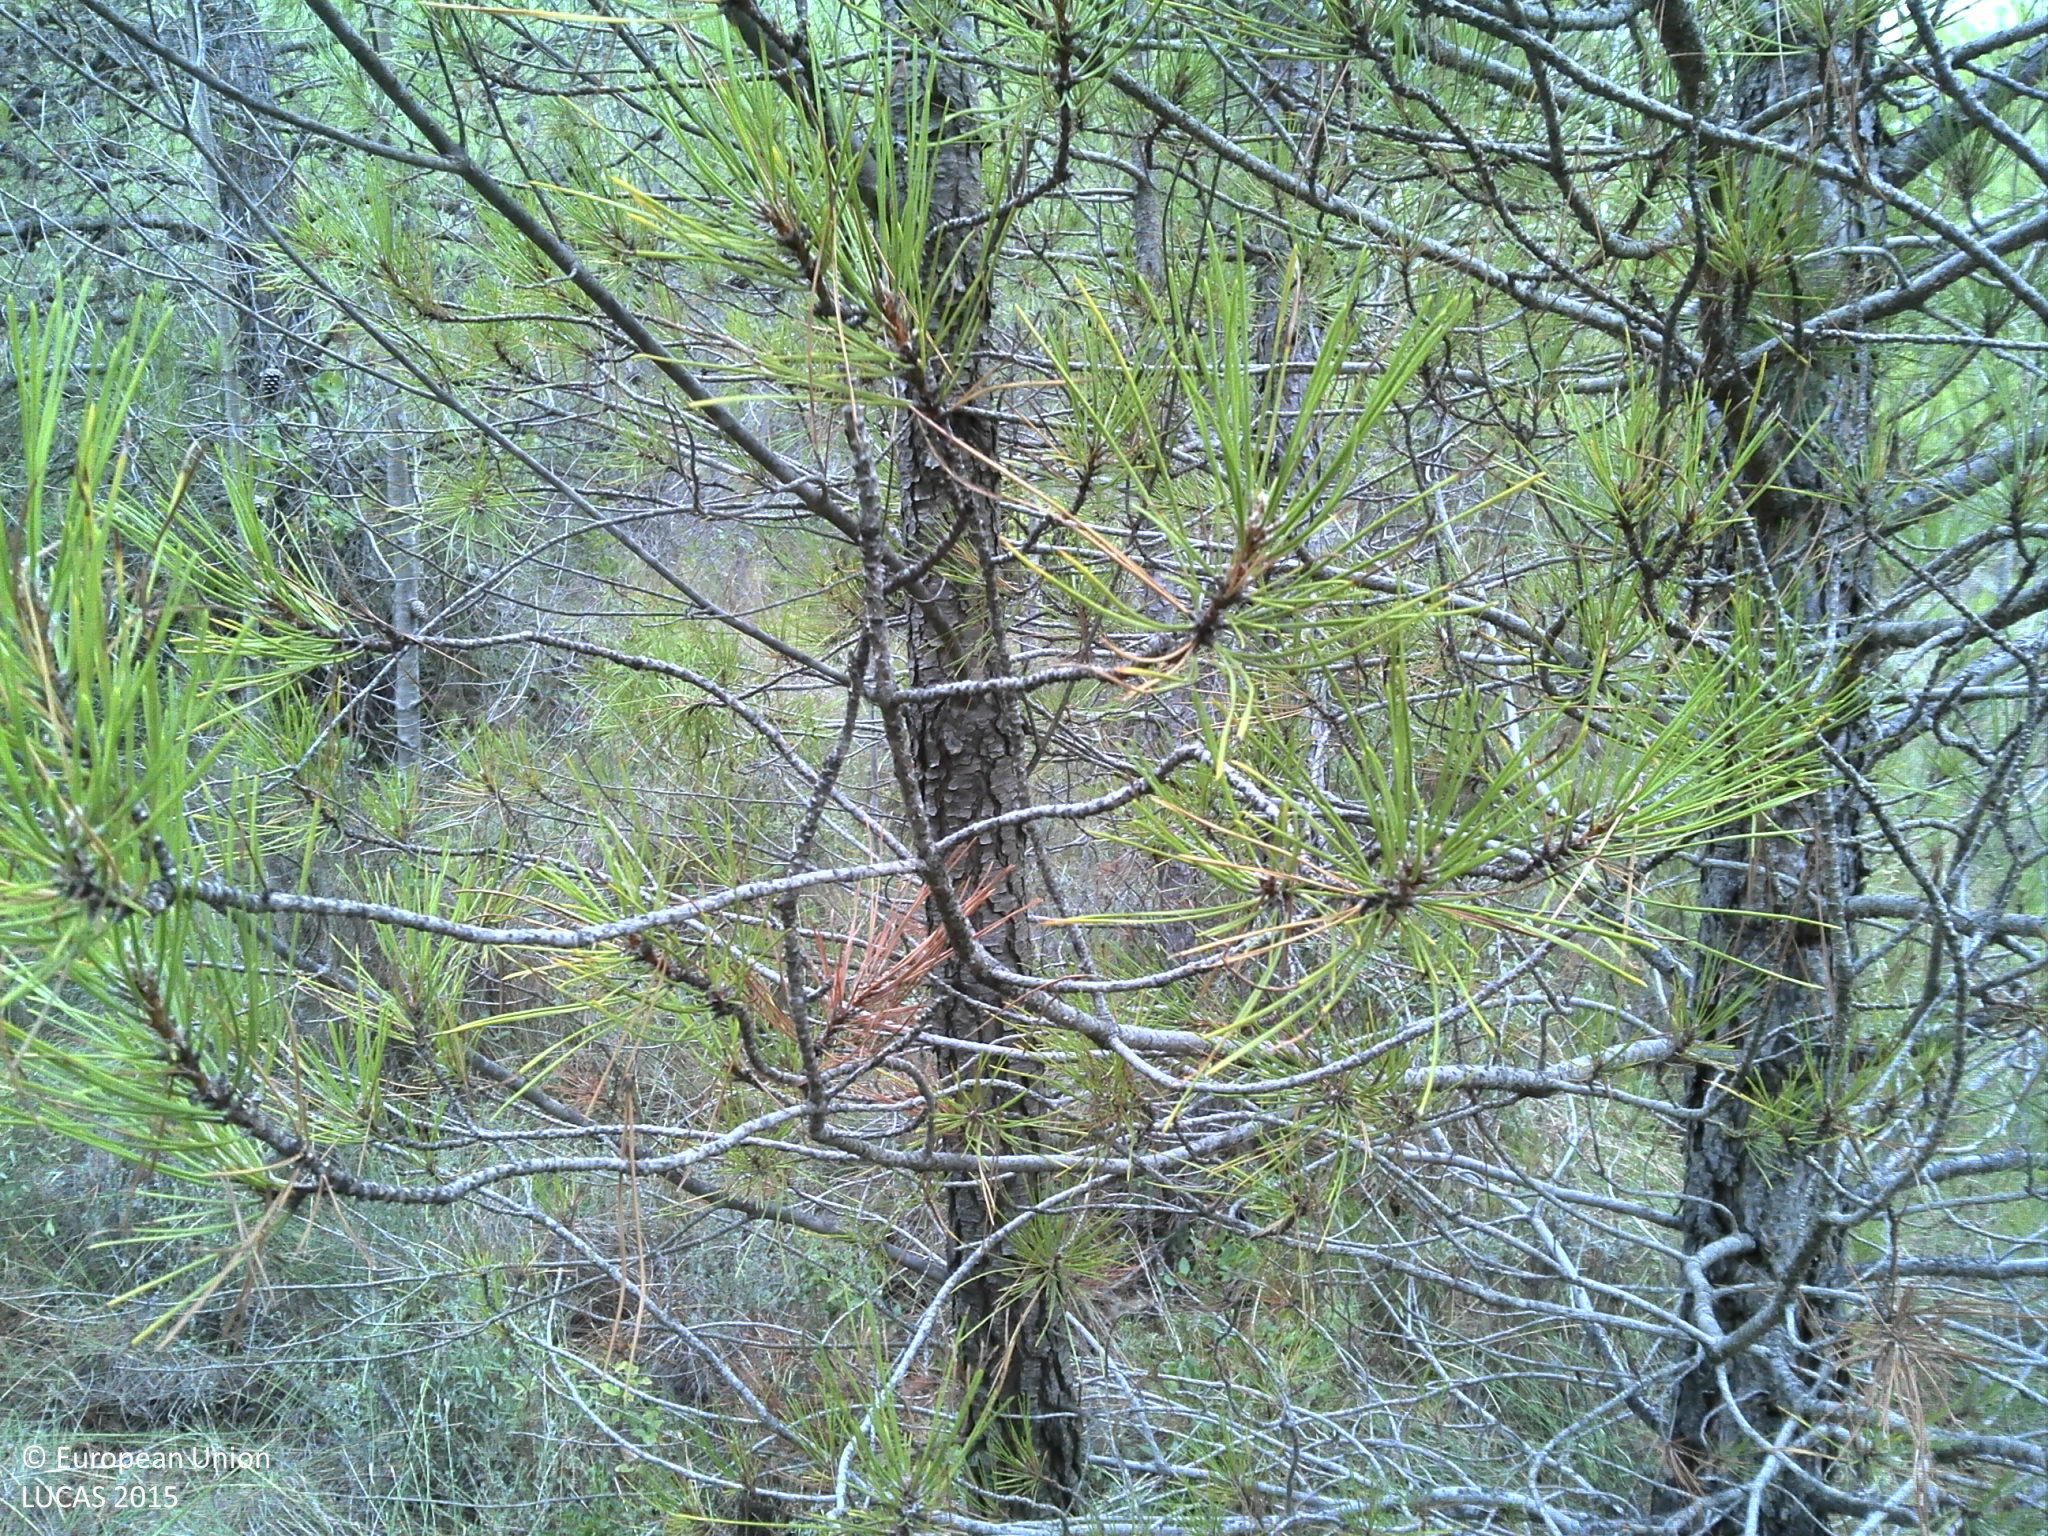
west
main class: Woodland
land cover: Pine dominated coniferous woodland
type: coniferous forest of the mediterranean region
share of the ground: > 75 %
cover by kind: coniferous forest trees 75 %, shrubs 10 %, herbaceous plants 5 %, lichens and mosses 5 %, unconsolidated bare surface 5 %
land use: Semi-natural and natural areas not in use
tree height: > 5 m
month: October
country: FR
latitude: 43.3323
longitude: 2.6947
